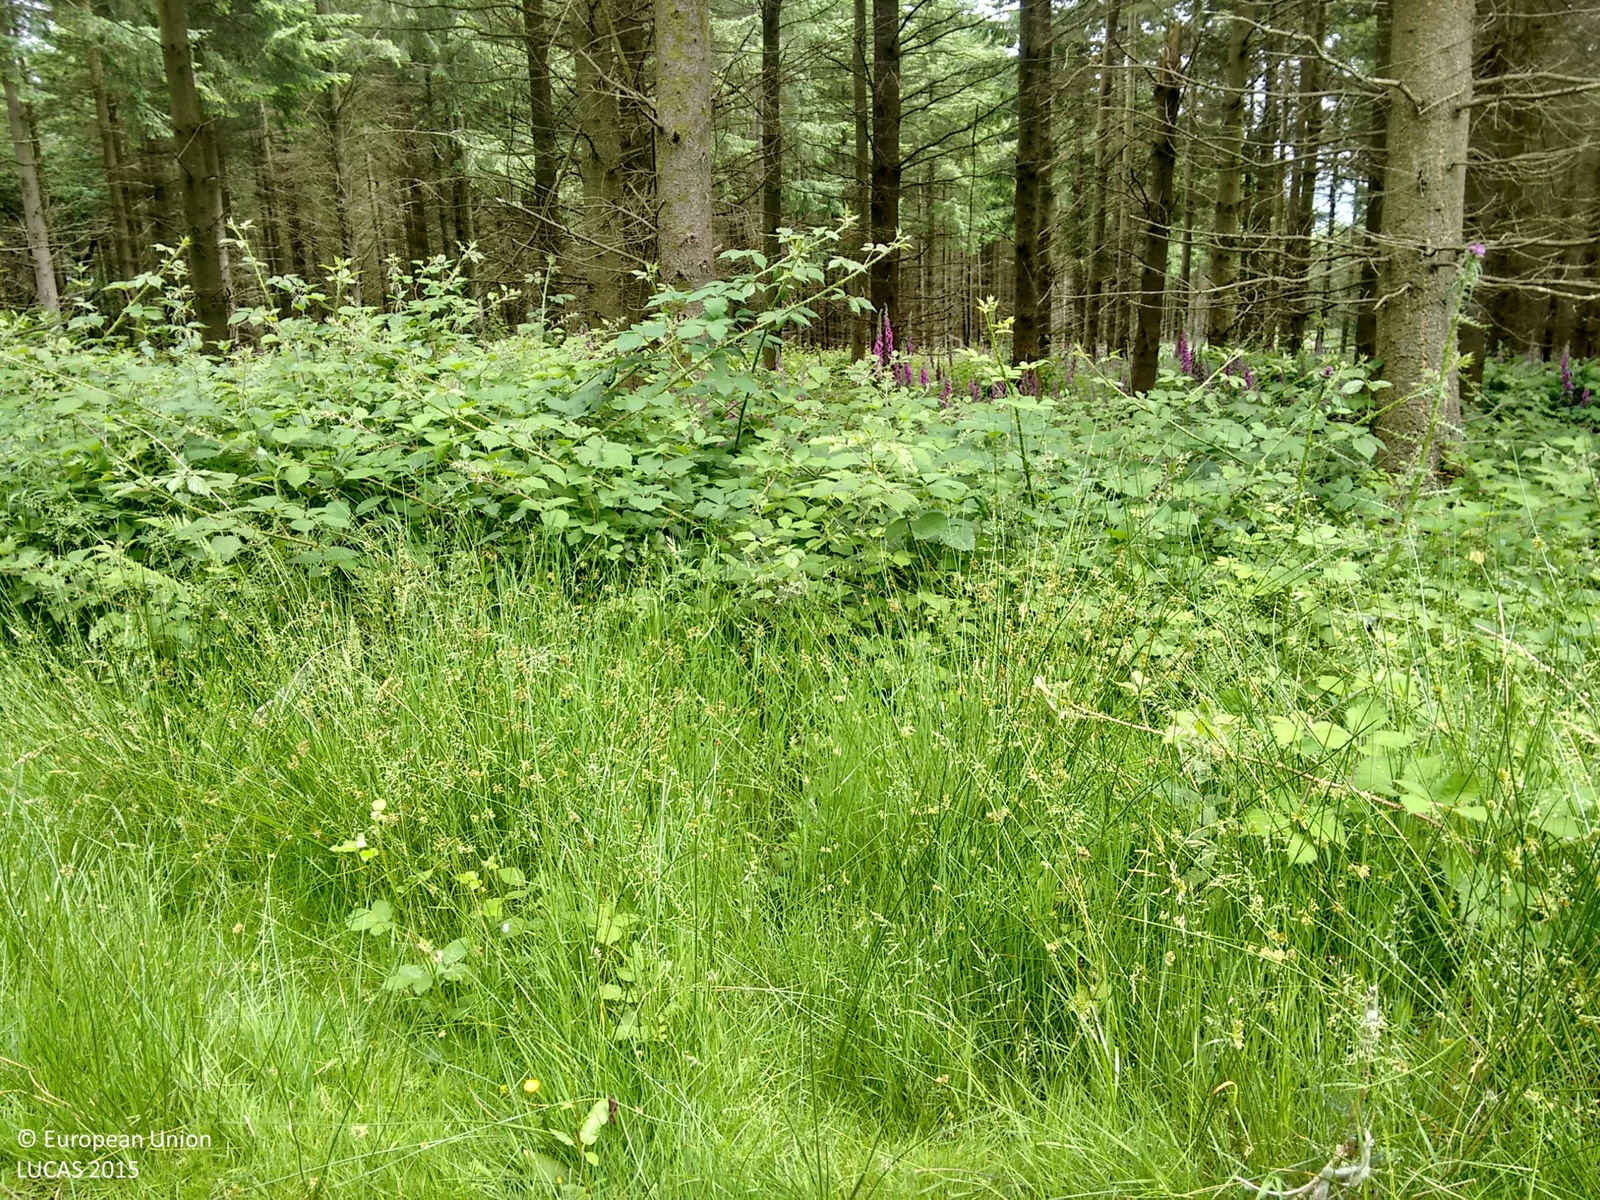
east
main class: Woodland
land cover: Spruce dominated coniferous woodland
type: exotic forest
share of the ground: > 75 %
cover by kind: coniferous forest trees 95 %, shrubs 5 %
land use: Forestry
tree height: > 5 m
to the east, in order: Spruce dominated coniferous woodland; Ditches and canals; Paved roads, cycling and walking lanes; Ditches and canals; Spruce dominated coniferous woodland; Tracks; Spruce dominated coniferous woodland; Tracks; Spruce dominated coniferous woodland
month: June
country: GB
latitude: 52.3017
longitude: -2.7856
